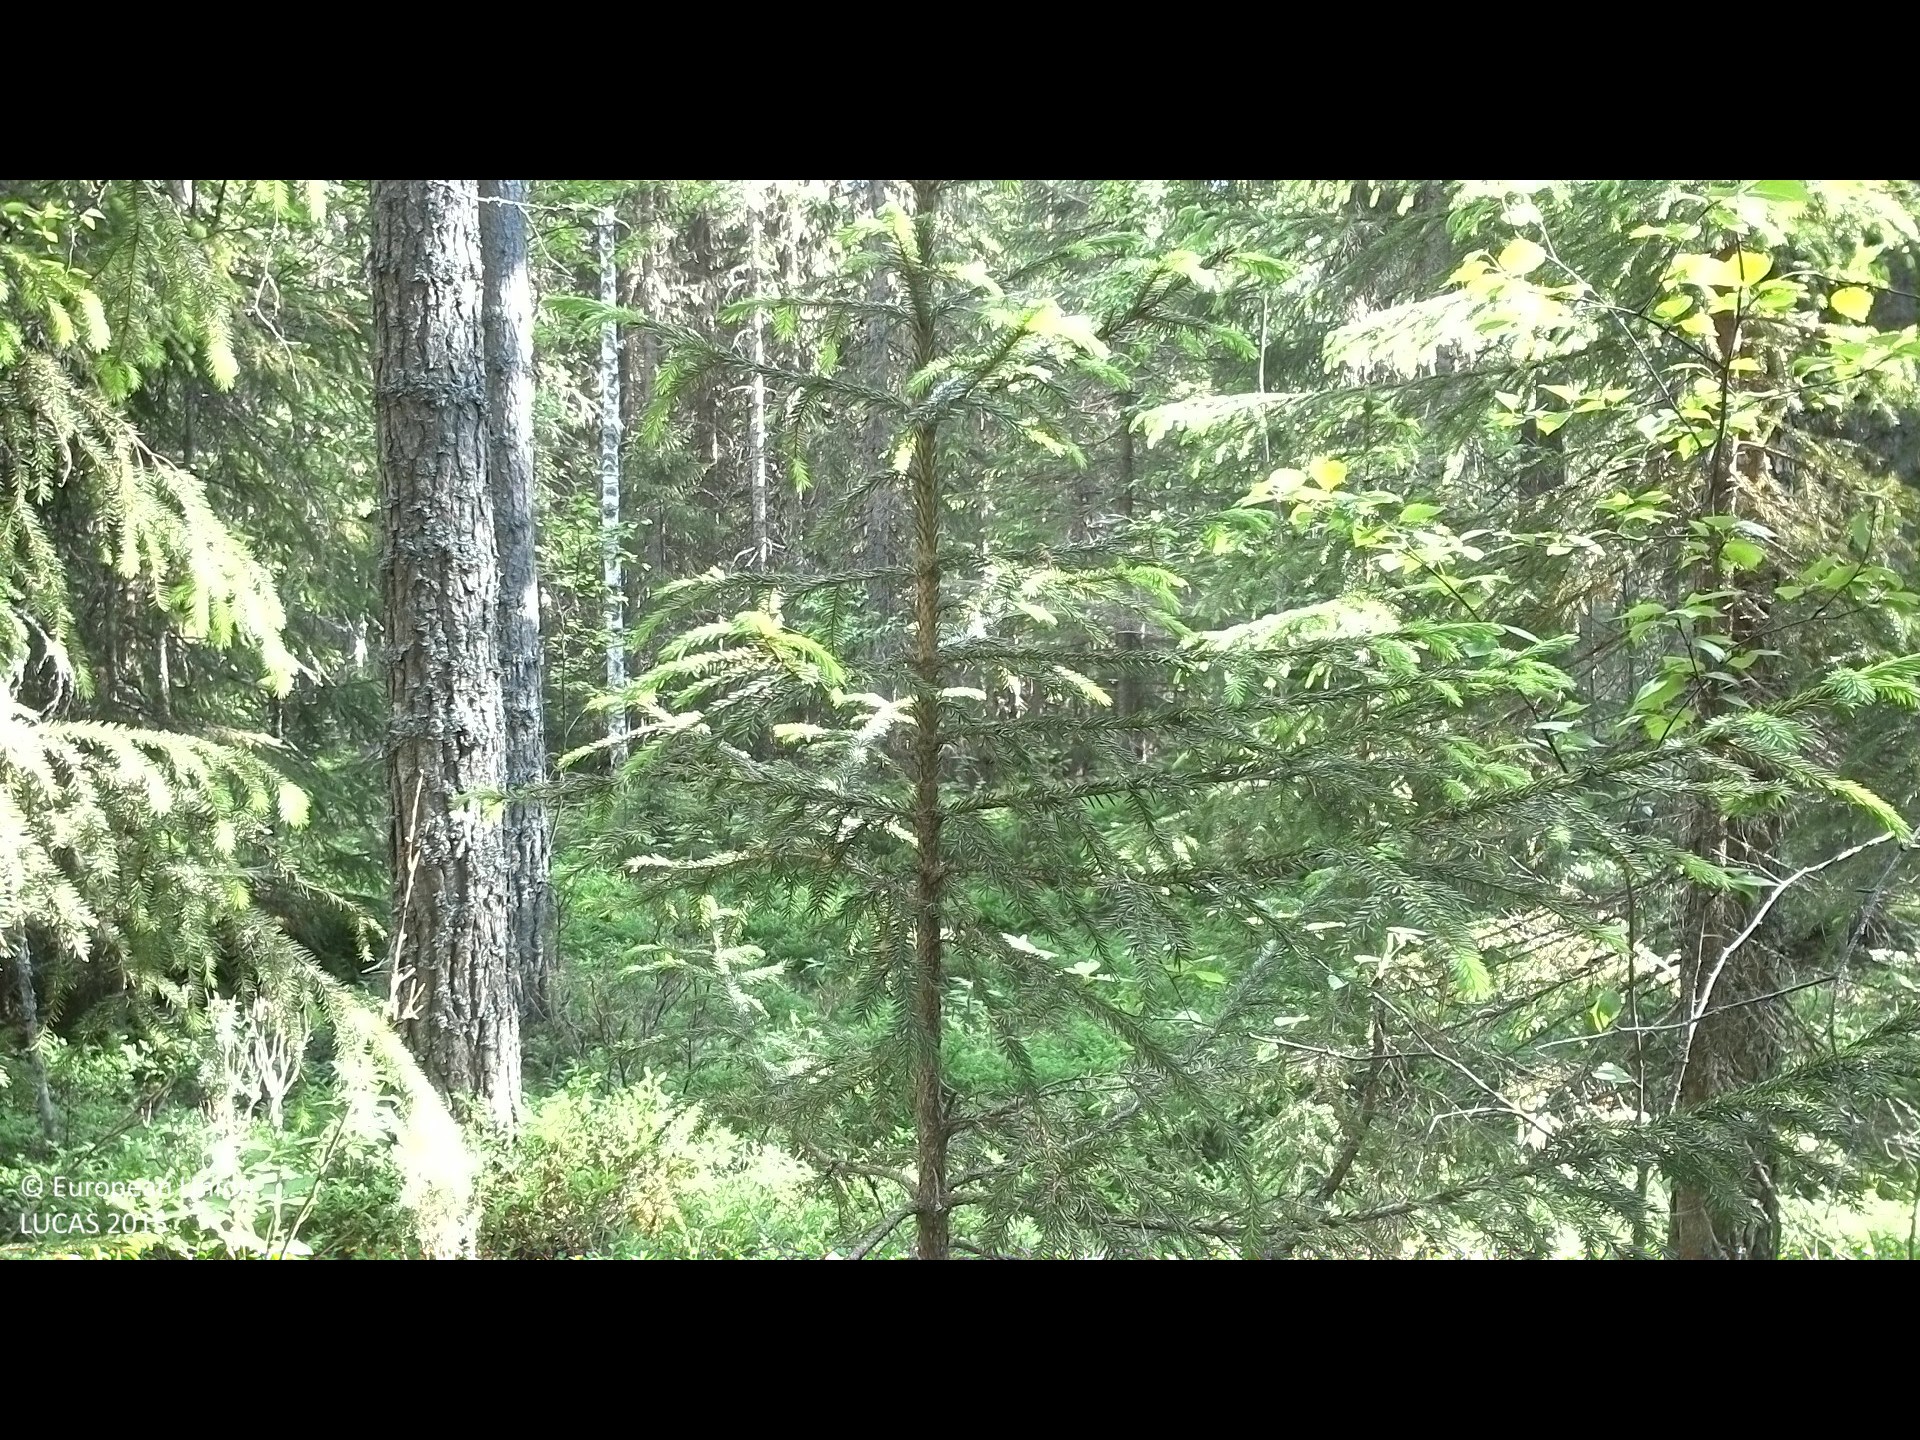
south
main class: Woodland
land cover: Spruce dominated mixed woodland
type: boreal forest
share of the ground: 50 - 75 %
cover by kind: coniferous forest trees 45 %, shrubs 30 %, broadleaved forest trees 15 %, lichens and mosses 10 %
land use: Forestry
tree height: > 5 m
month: June
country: SE
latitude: 62.0016
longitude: 16.0728
